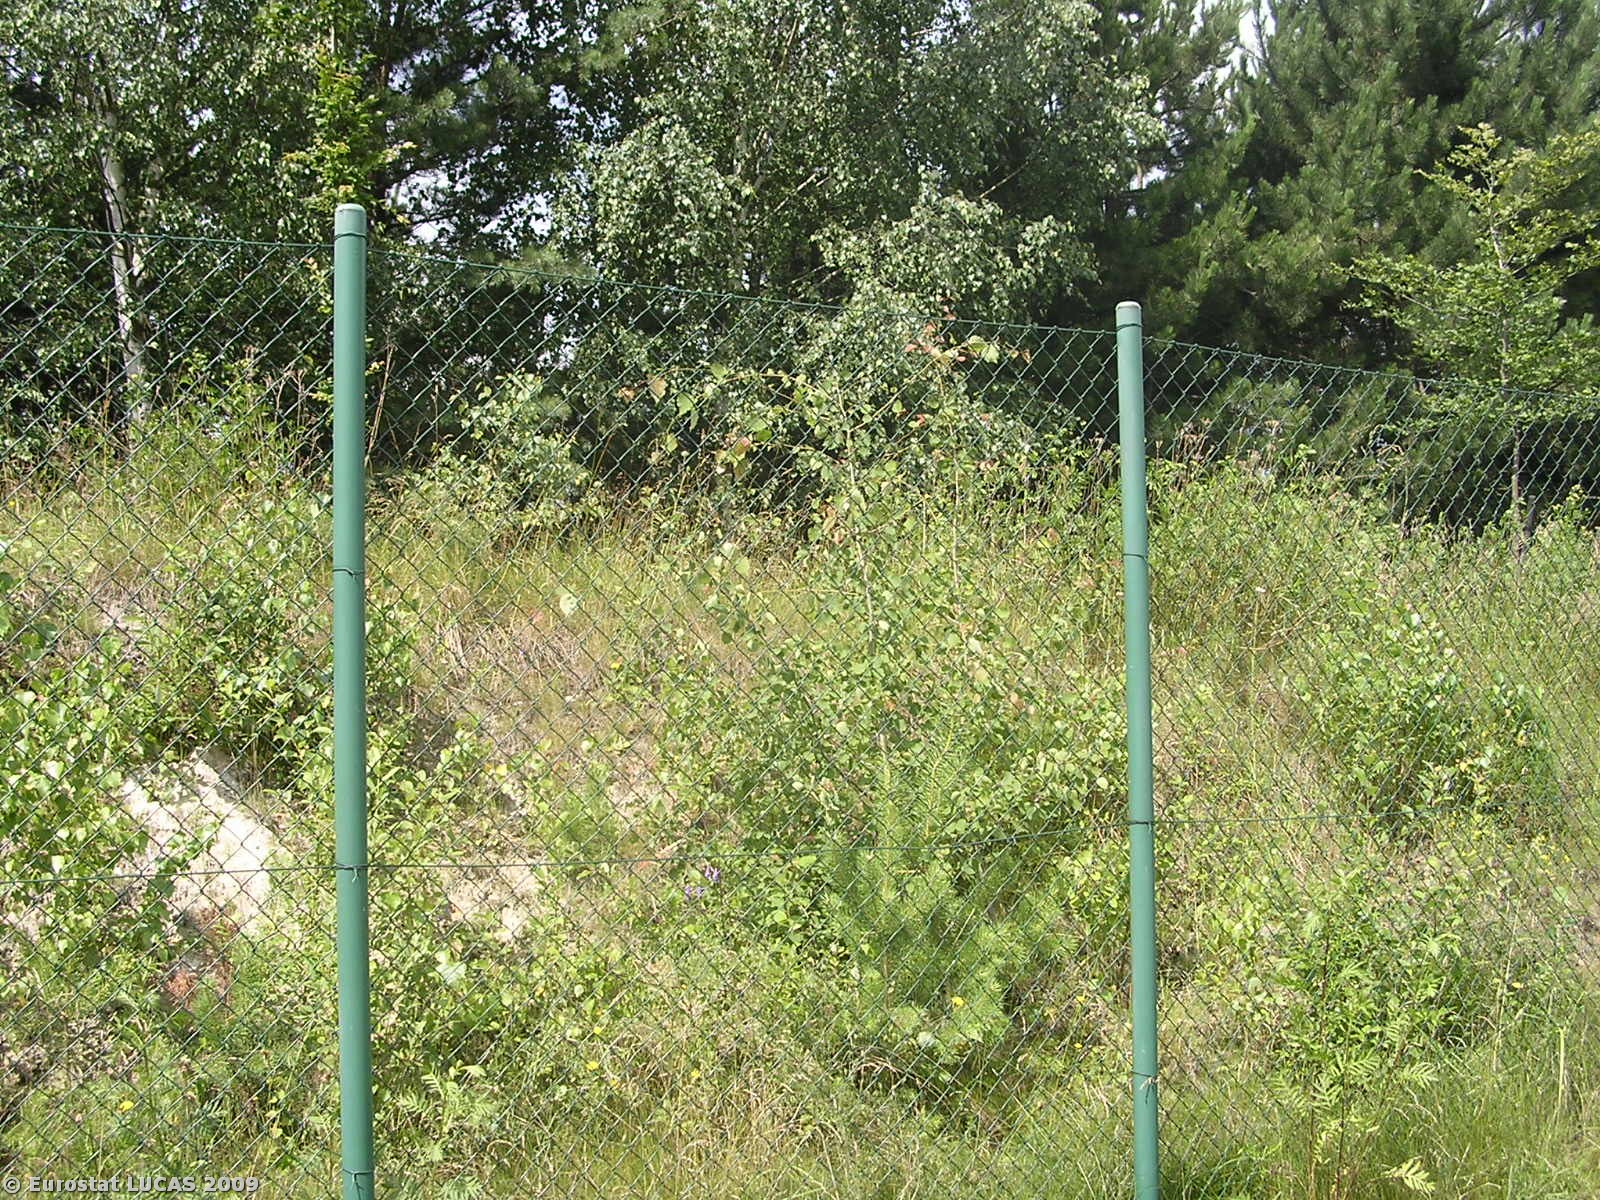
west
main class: Grassland
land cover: Grassland without tree/shrub cover
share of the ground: > 75 %
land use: Community services
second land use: Sport
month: July
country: CZ
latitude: 50.6700
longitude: 14.5438
